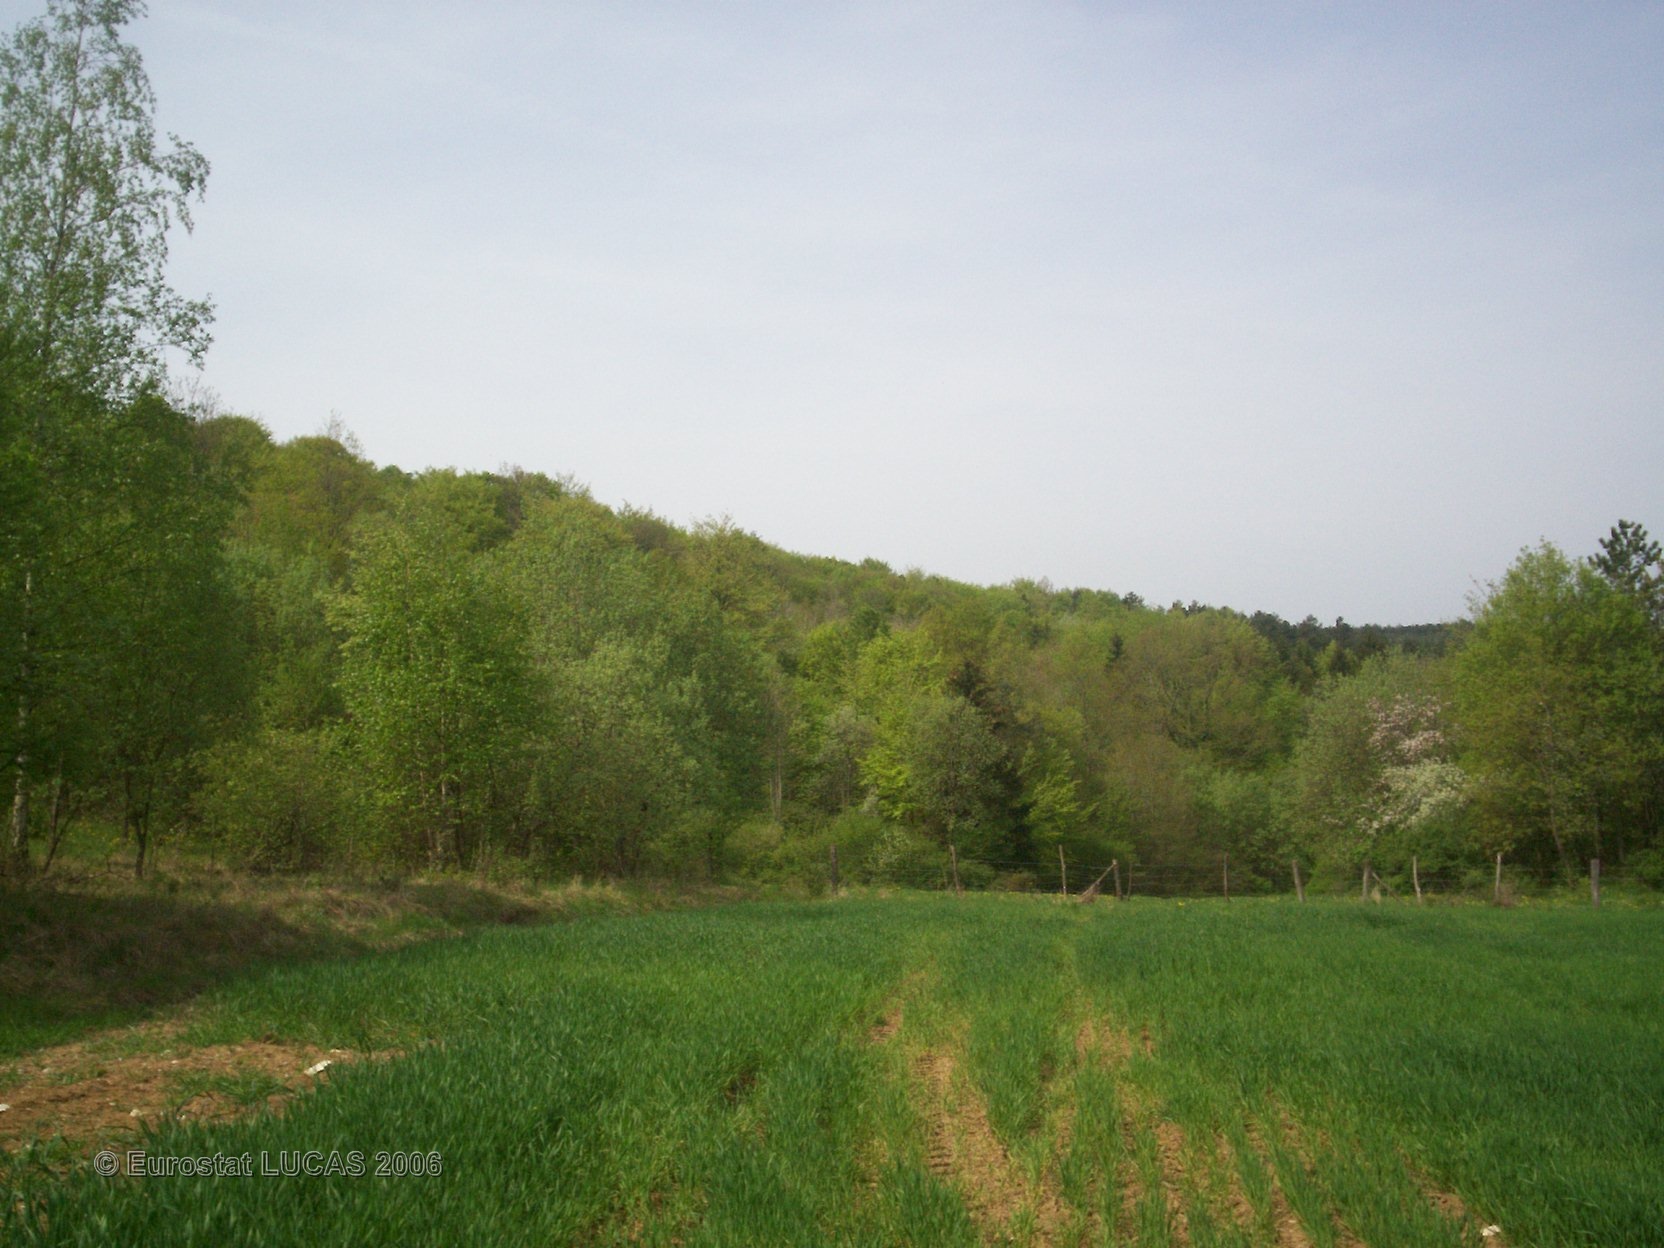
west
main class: Cropland
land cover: Barley
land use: Agriculture (excluding fallow land and kitchen gardens)
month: May
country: FR
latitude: 48.3896
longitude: 5.2049
